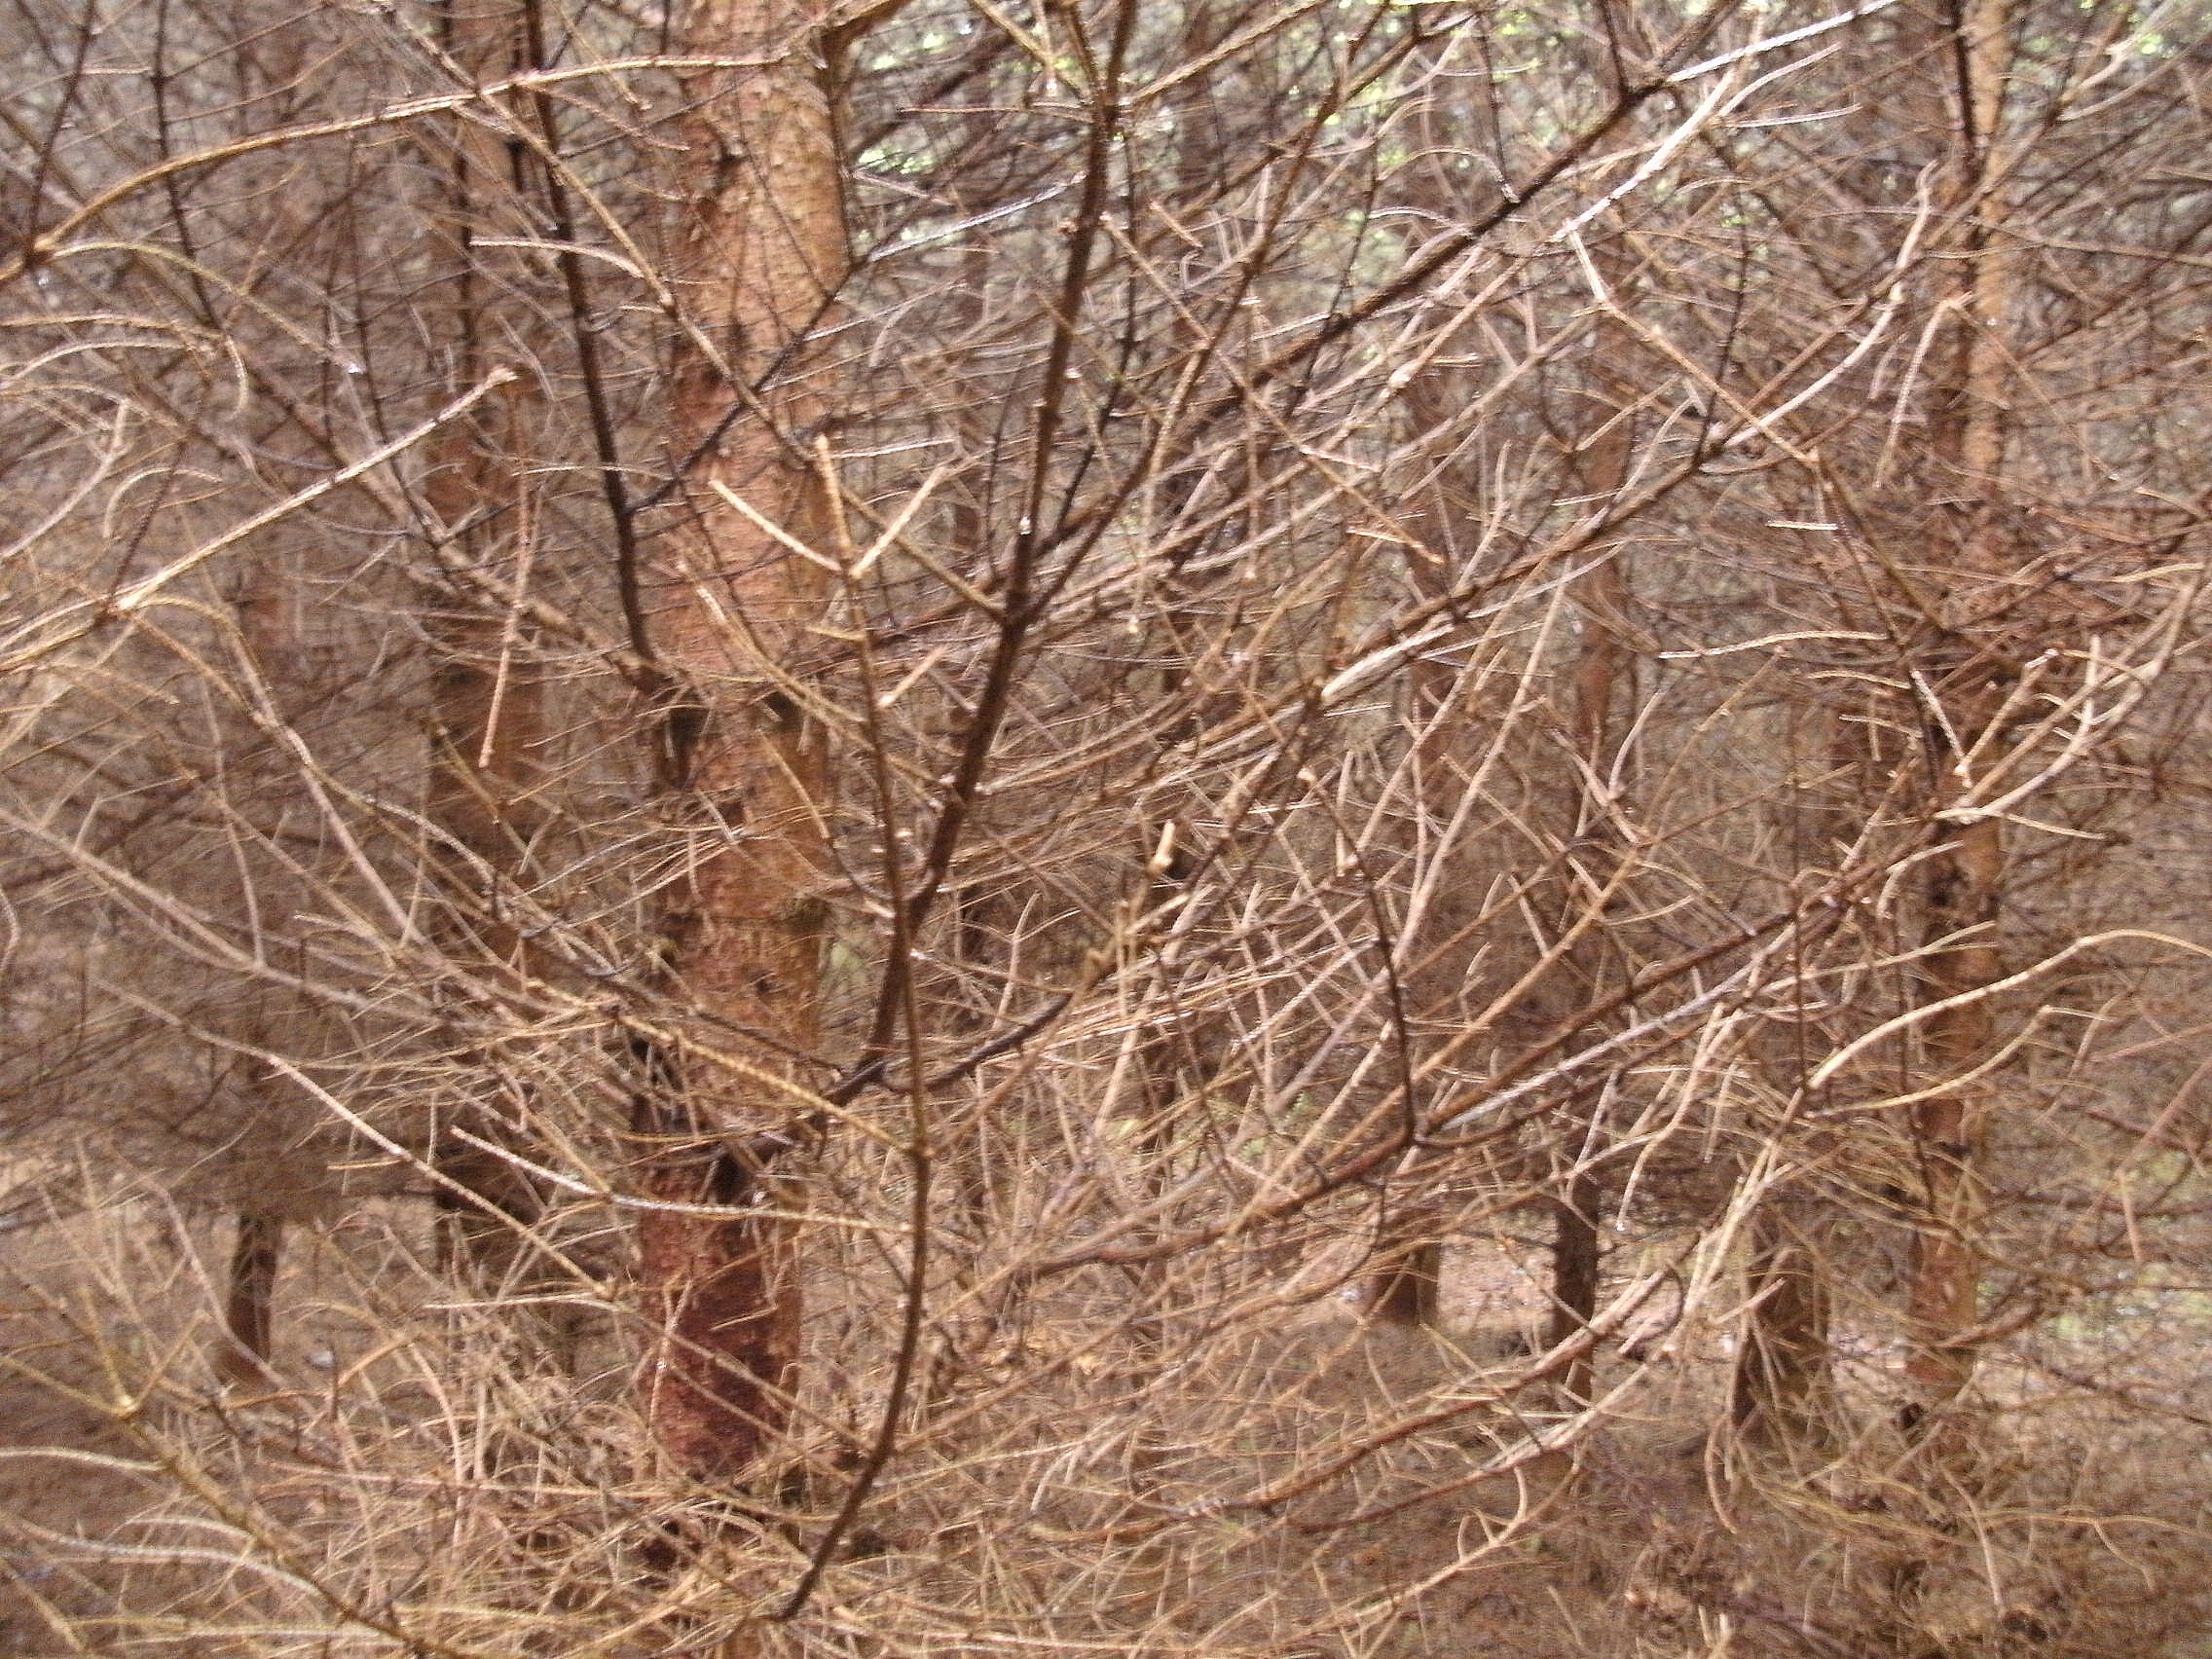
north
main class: Woodland
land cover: Spruce dominated coniferous woodland
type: hemiboreal forest and nemoral coniferous forest and mixed broadleaved-coniferous forest
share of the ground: > 75 %
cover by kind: coniferous forest trees 95 %, unconsolidated bare surface 5 %
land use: Forestry
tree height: > 5 m
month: May
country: AT
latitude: 48.4031
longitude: 13.4710
